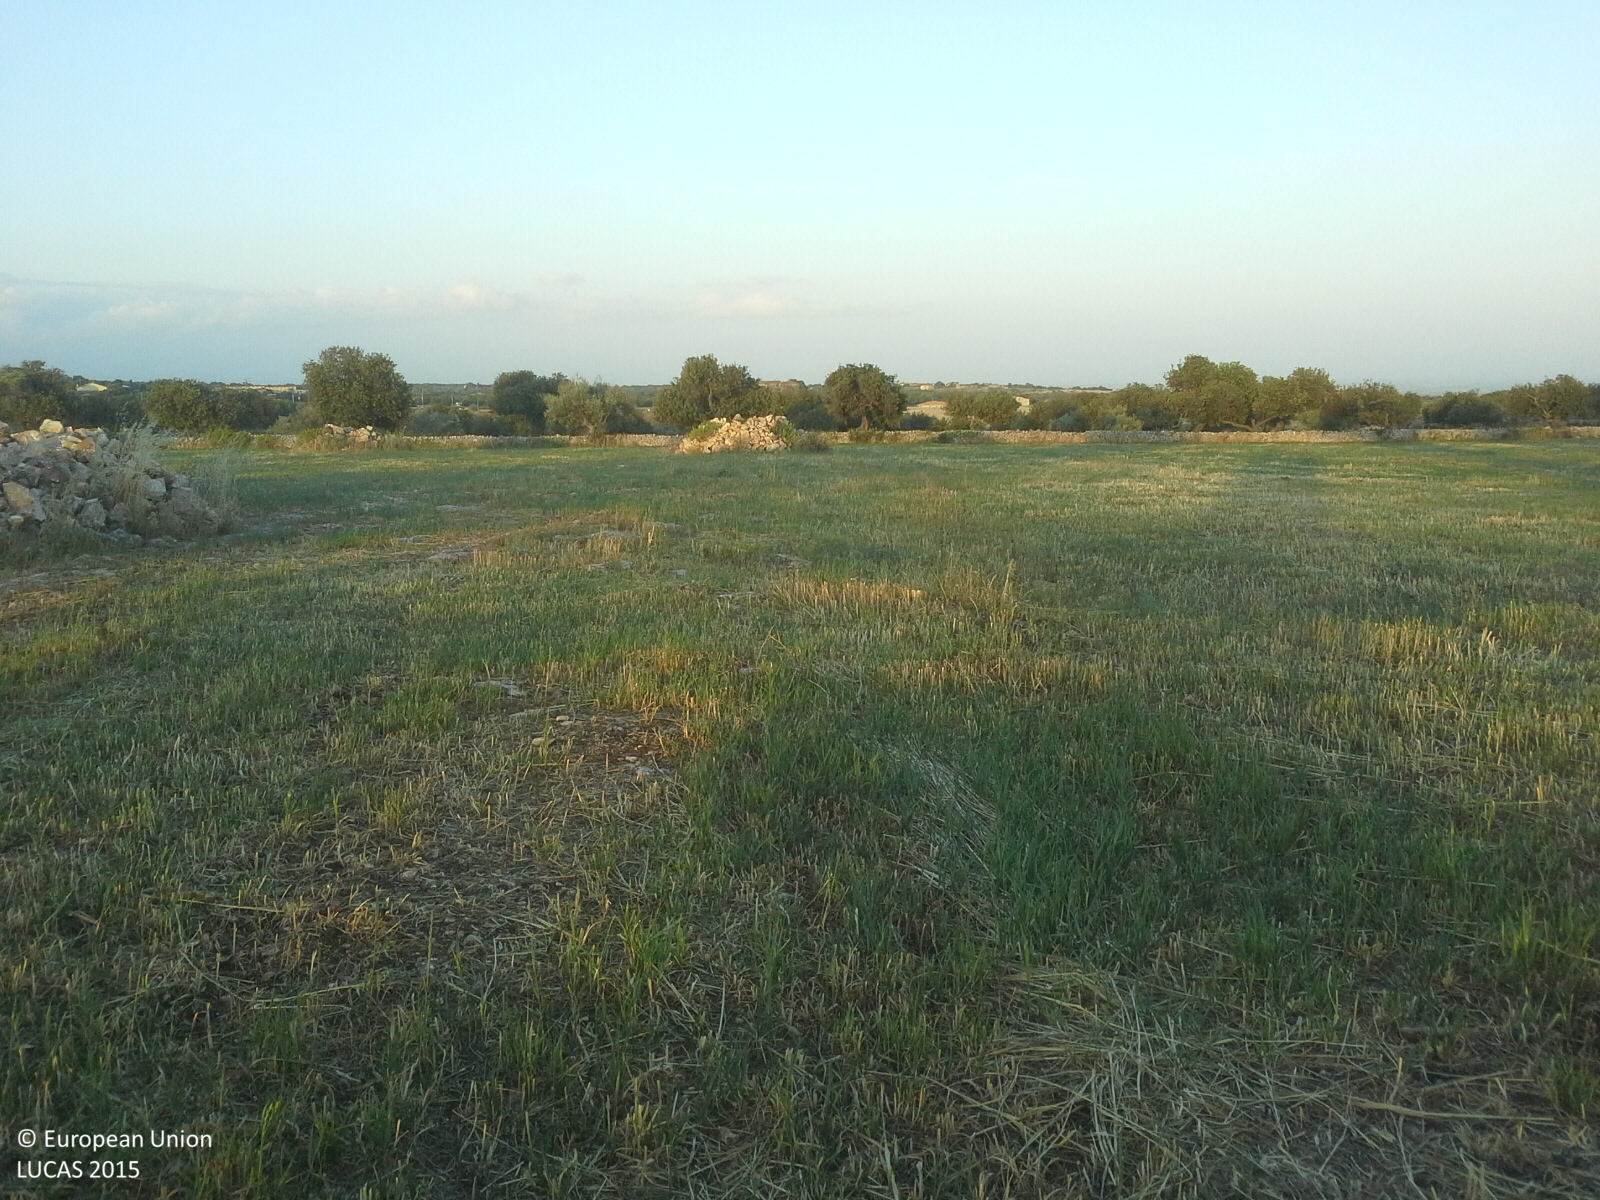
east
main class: Cropland
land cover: Mixed cereals for fodder
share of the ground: > 75 %
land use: Agriculture (excluding fallow land and kitchen gardens)
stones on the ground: < 10 %
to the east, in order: Mixed cereals for fodder; Rocks and stones; Mixed cereals for fodder; Dry stone walls; Mixed cereals for fodder; Single bushes/trees; Mixed cereals for fodder; Single bushes/trees
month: May
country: IT
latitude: 36.7888
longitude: 14.8134
